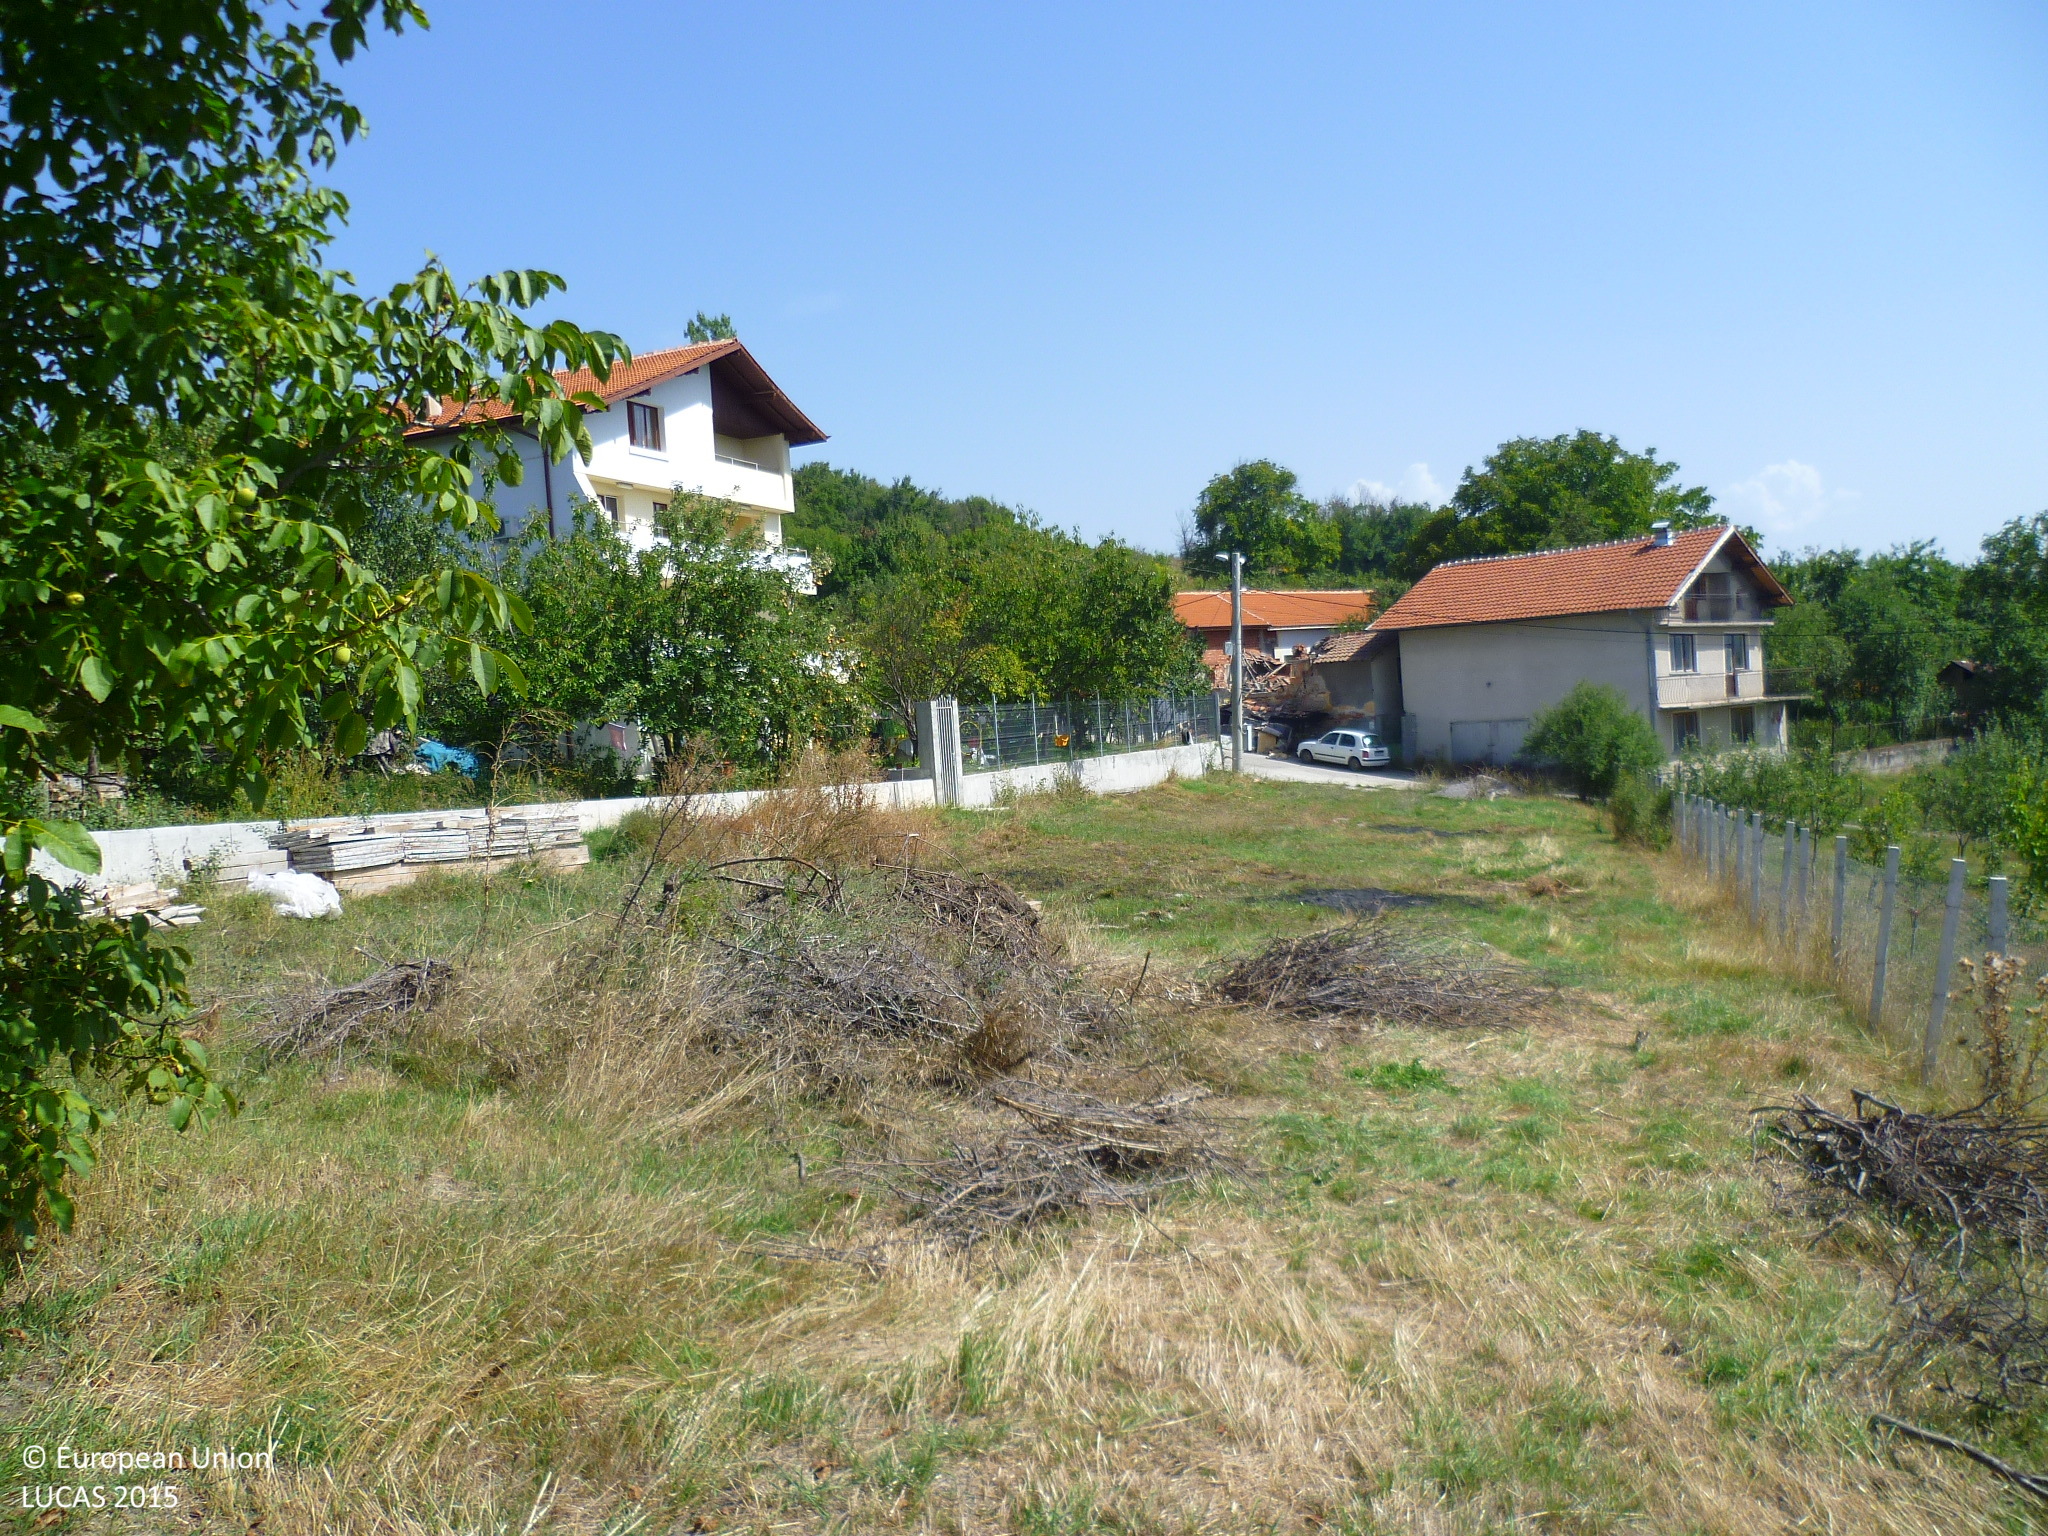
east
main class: Cropland
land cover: Apple fruit
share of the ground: 50 - 75 %
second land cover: Spontaneously vegetated surfaces
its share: 50 - 75 %
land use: Kitchen garden
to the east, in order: Apple fruit; Spontaneously vegetated surfaces; Artificial constructions in urban areas; Broadleaved woodland; Tracks; Grassland without tree/shrub cover; Broadleaved woodland; Tracks; Nuts trees
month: September
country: BG
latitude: 42.6206
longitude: 22.9642
